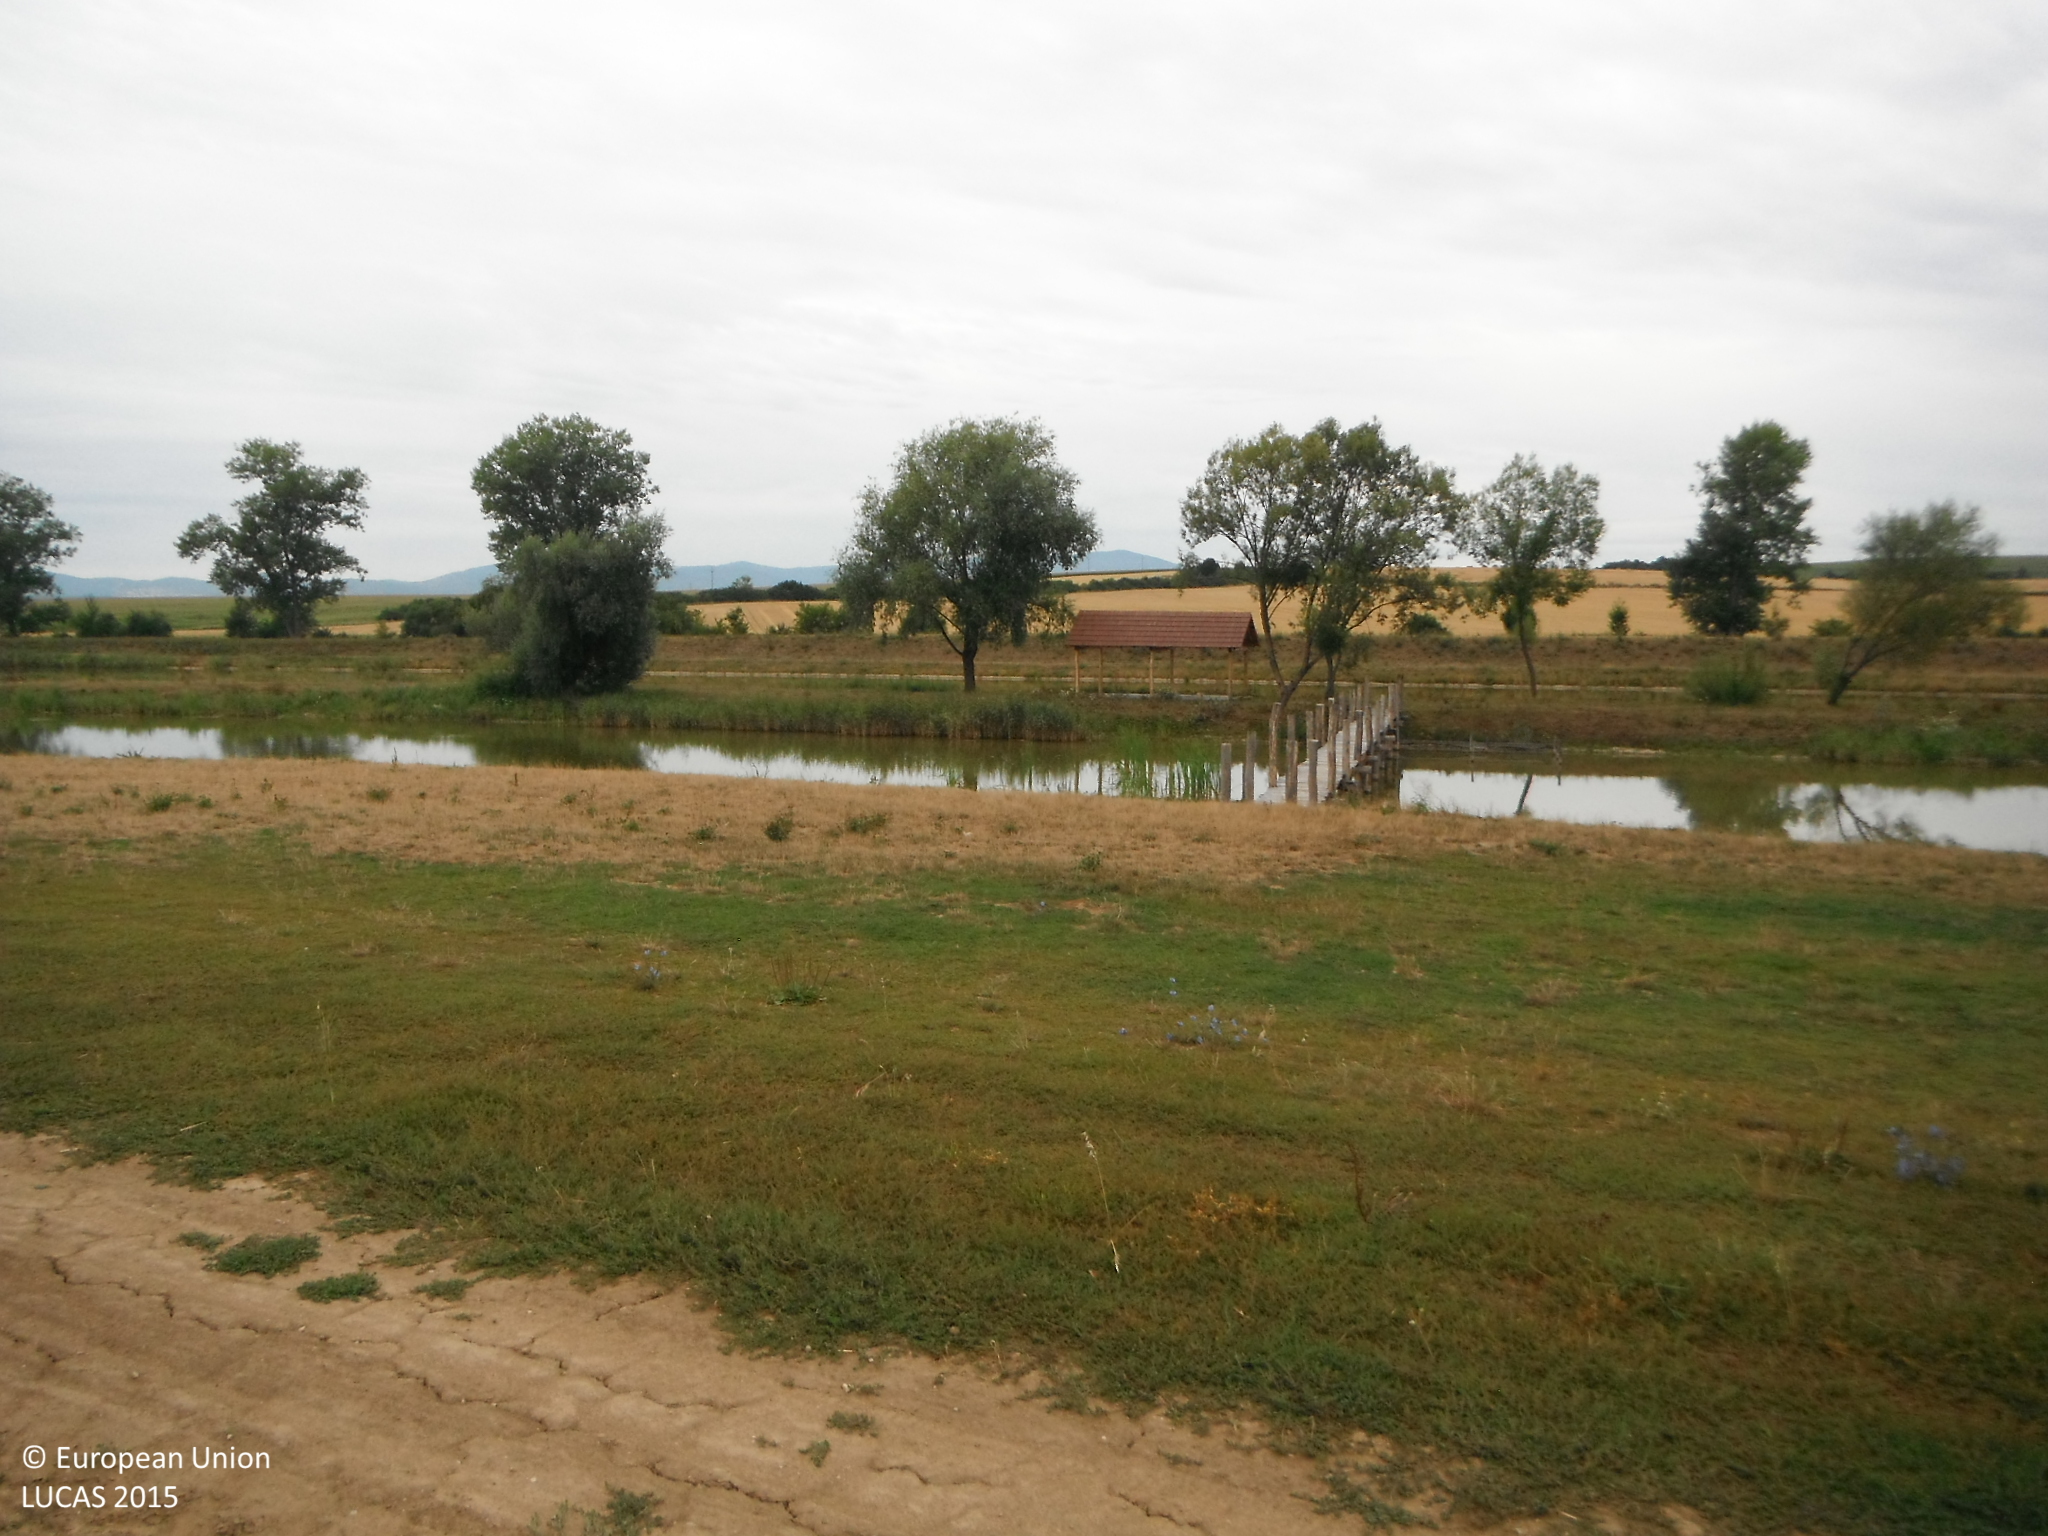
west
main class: Cropland
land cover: Permanent crops (only in case pi)
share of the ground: 50 - 75 %
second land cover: Grassland without tree/shrub cover
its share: > 75 %
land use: Agriculture (excluding fallow land and kitchen gardens)
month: July
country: SK
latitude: 48.6510
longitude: 18.3096
